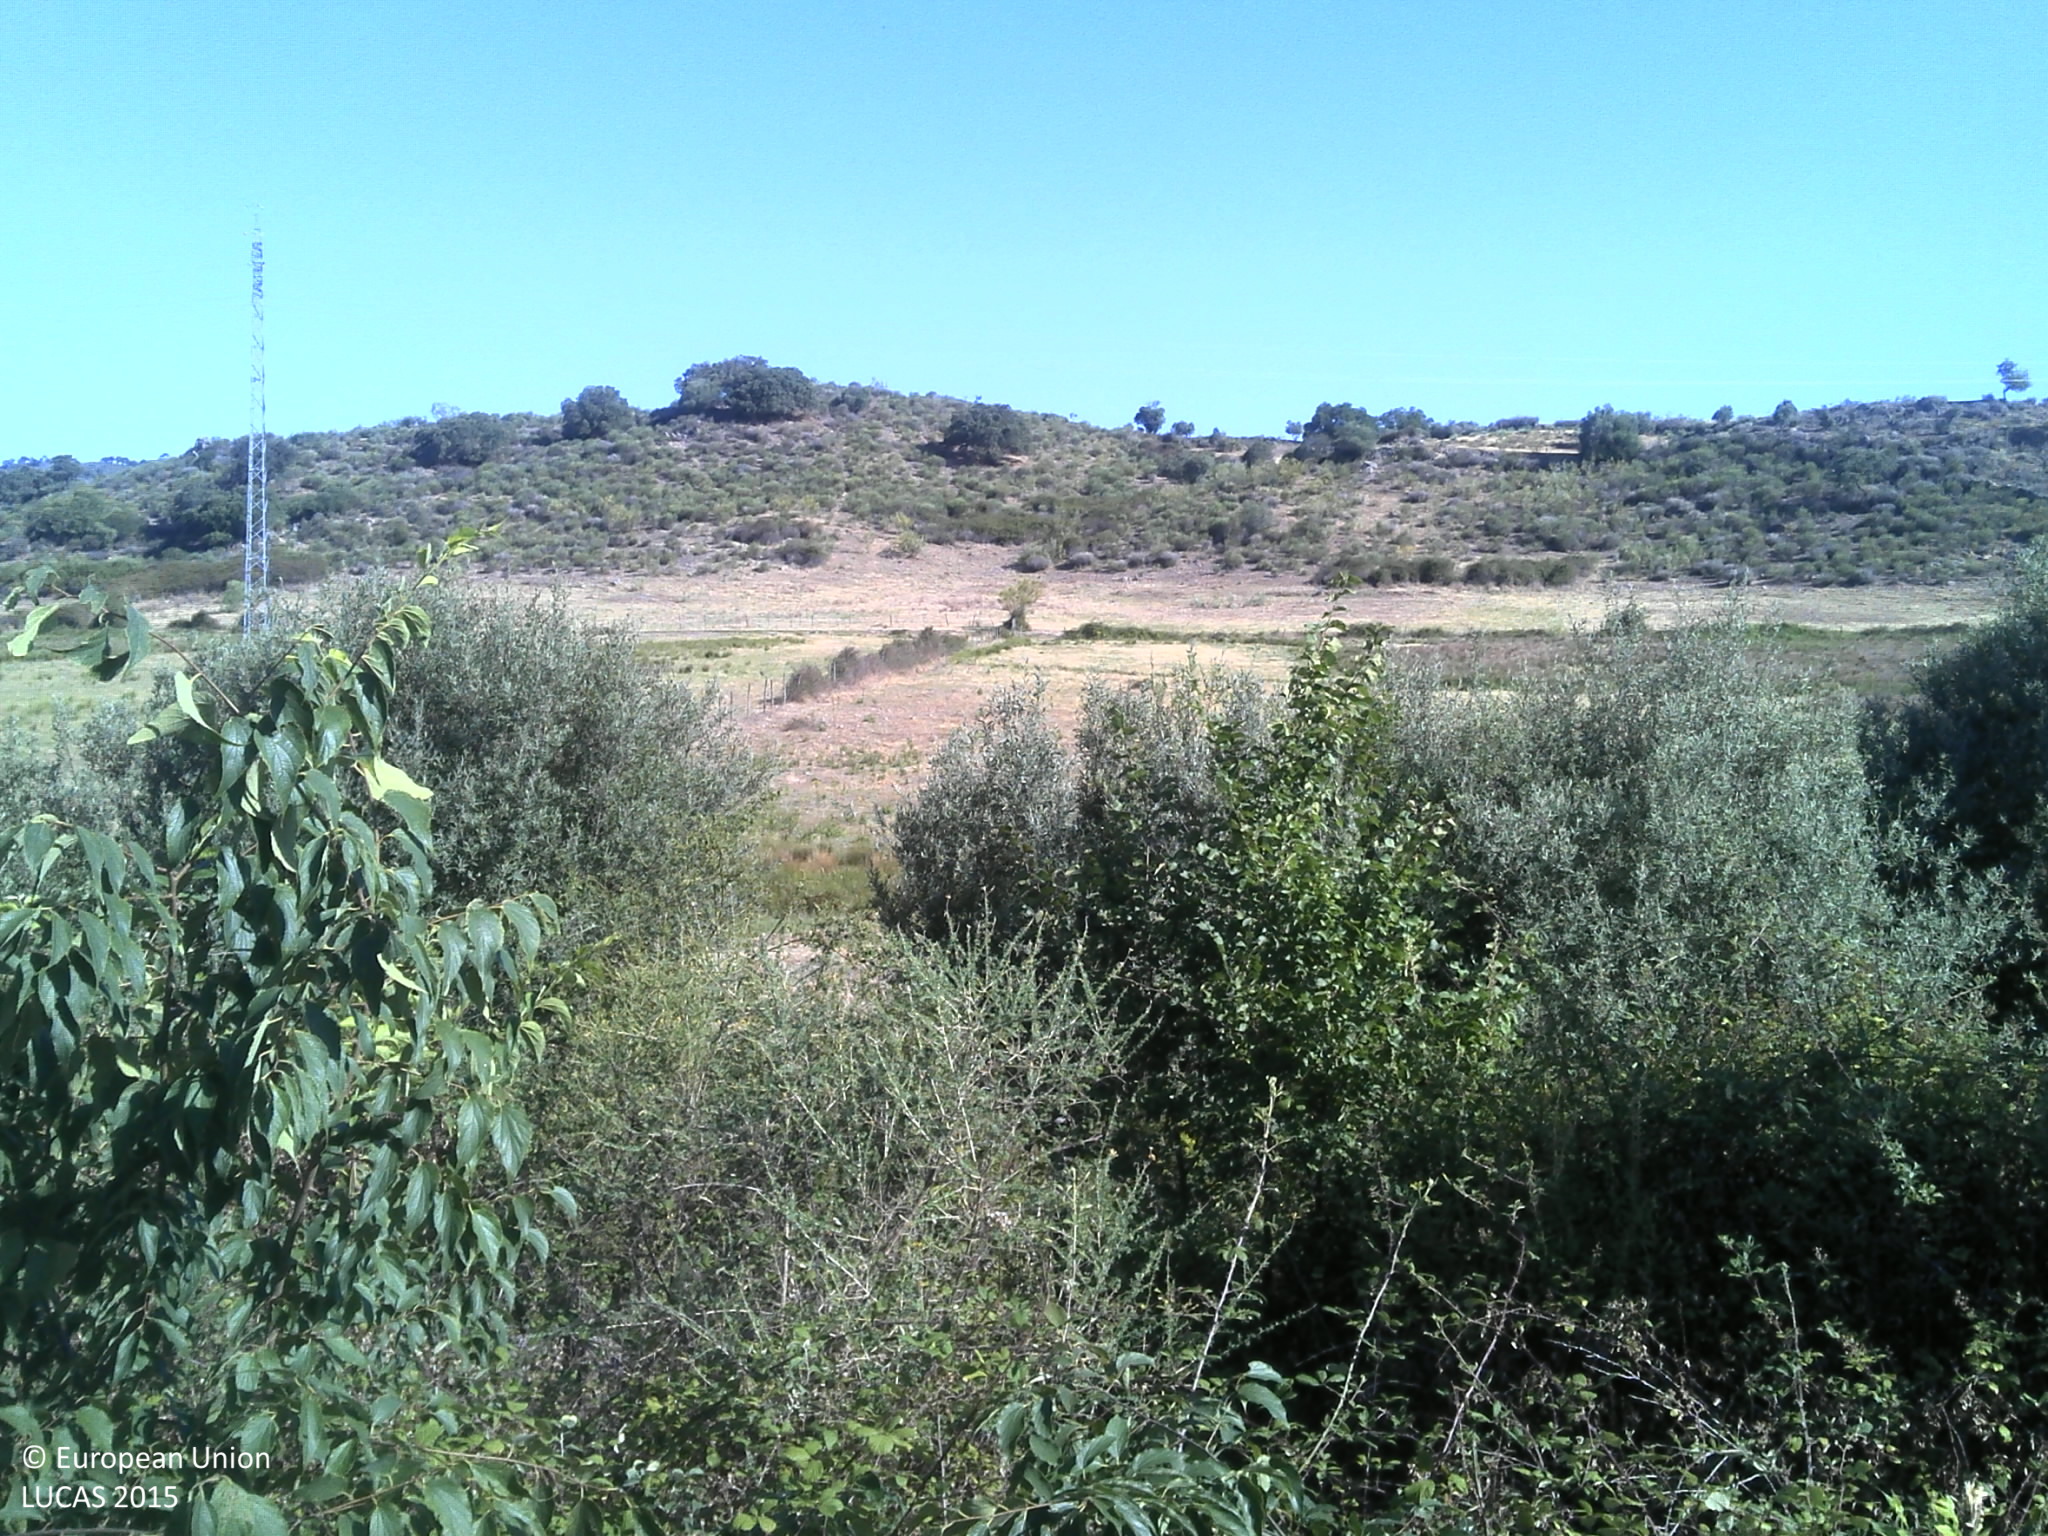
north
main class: Grassland
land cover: Grassland with sparse tree/shrub cover
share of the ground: 50 - 75 %
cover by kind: herbaceous plants 55 %, unconsolidated bare surface 30 %, broadleaved forest trees 5 %, shrubs 5 %
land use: Agriculture (excluding fallow land and kitchen gardens)
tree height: > 5 m
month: June
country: PT
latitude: 39.9104
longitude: -7.2319
